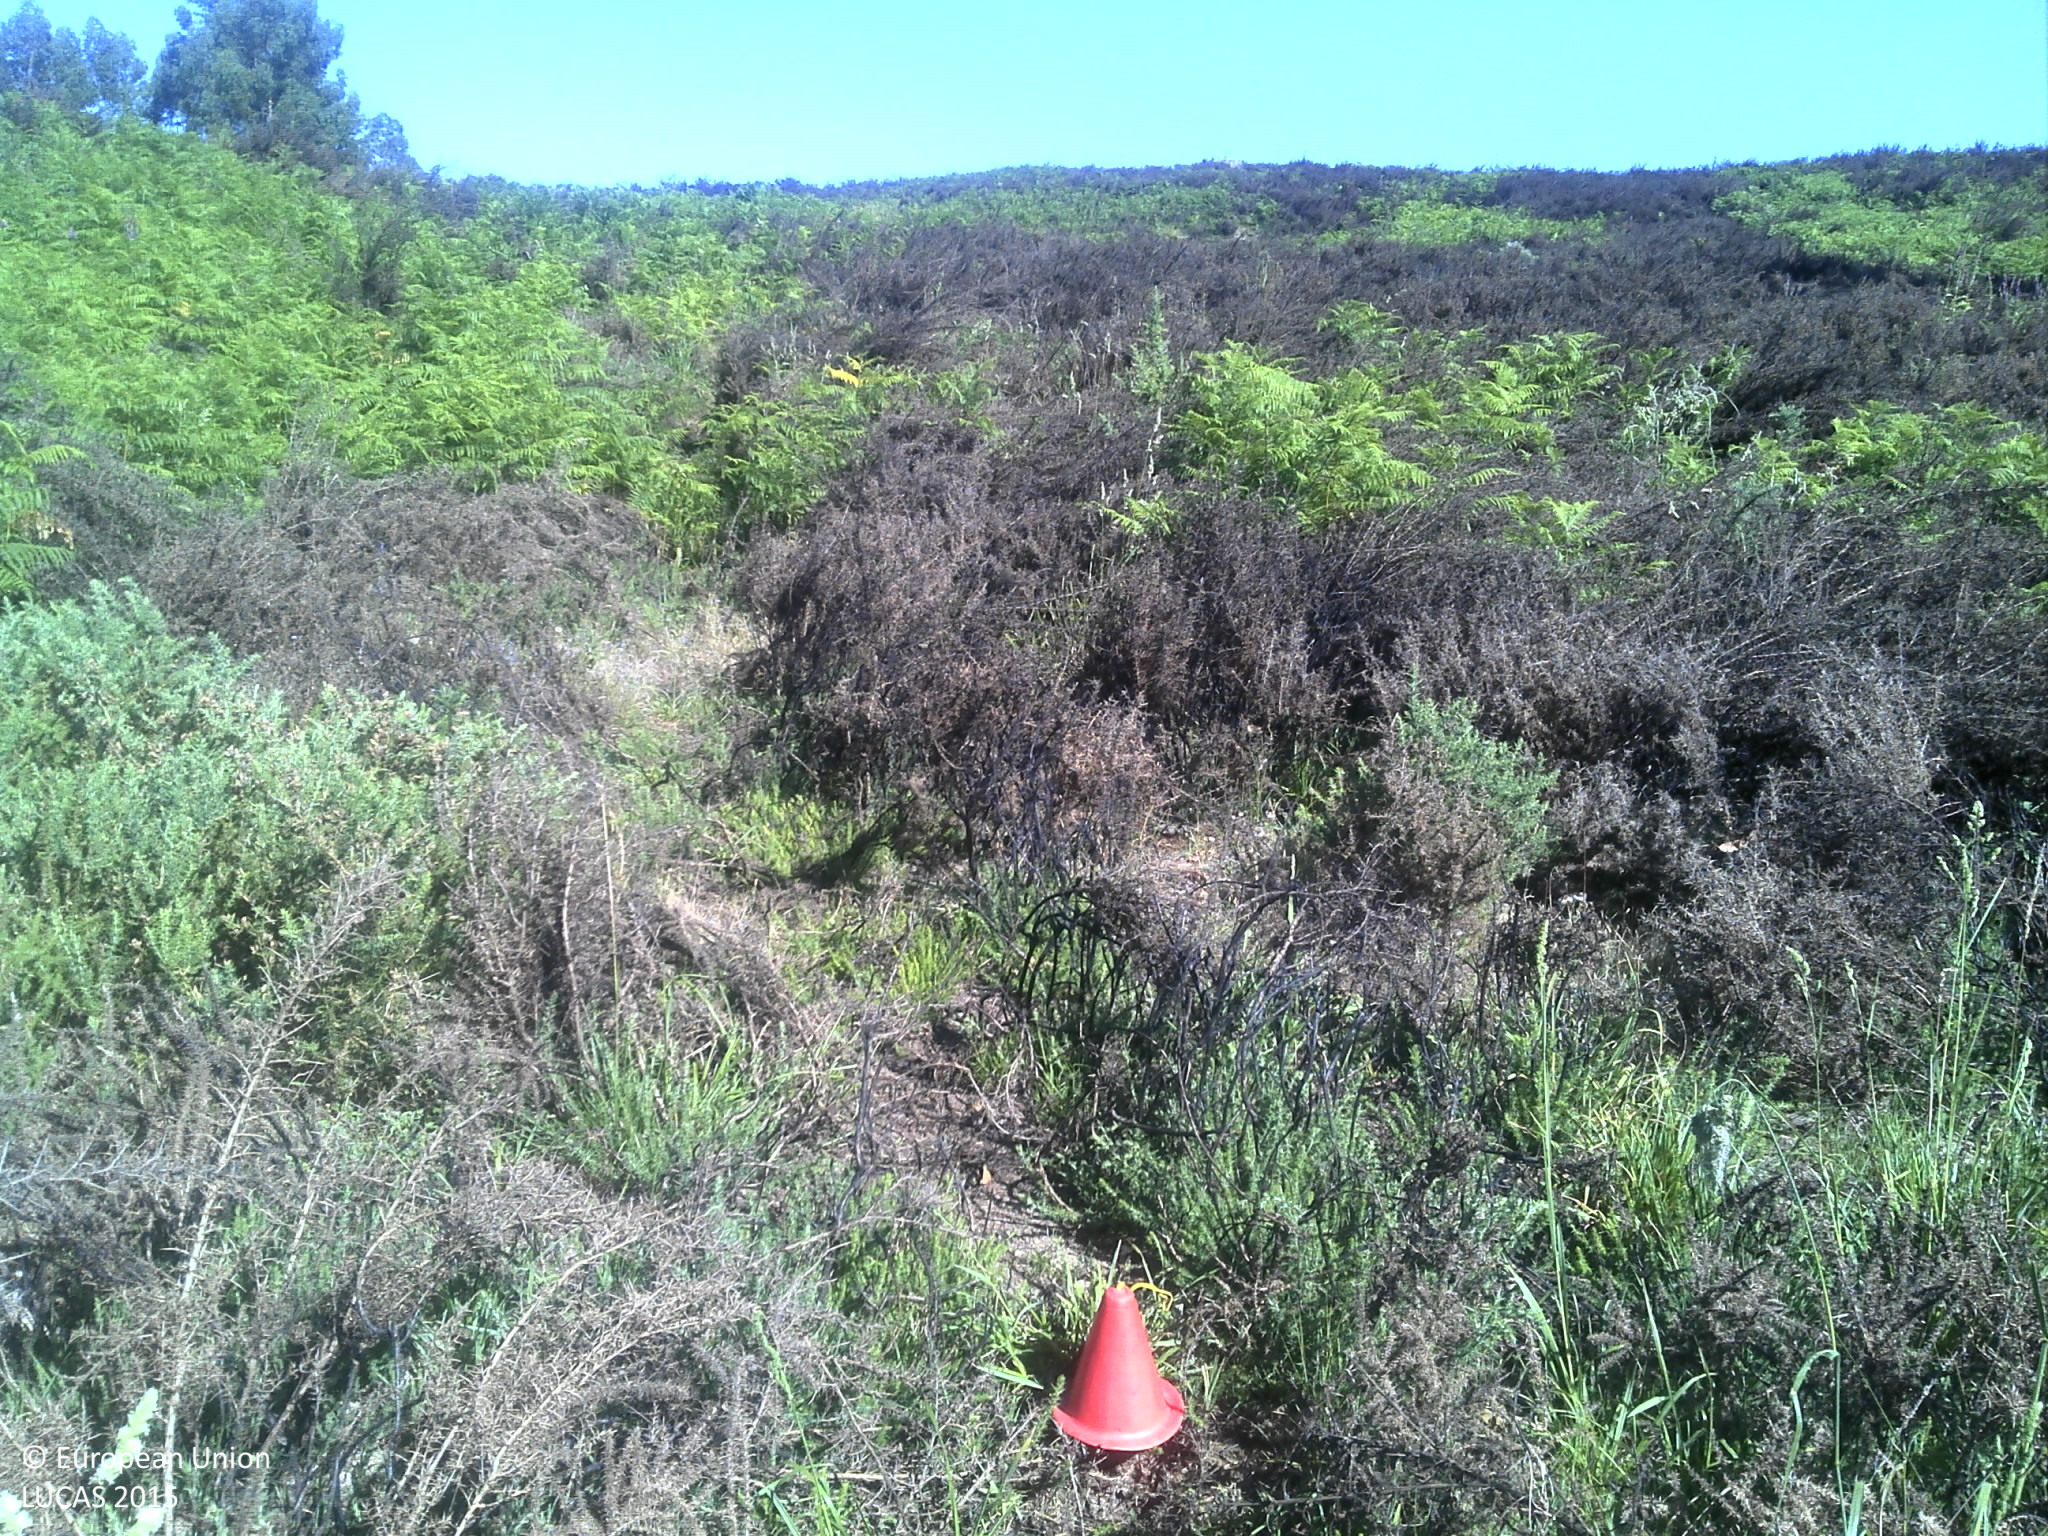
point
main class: Shrubland
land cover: Shrubland without tree cover
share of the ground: > 75 %
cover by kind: shrubs 85 %, herbaceous plants 10 %, unconsolidated bare surface 5 %
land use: Agriculture (excluding fallow land and kitchen gardens)
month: June
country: PT
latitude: 41.4836
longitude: -8.2192
